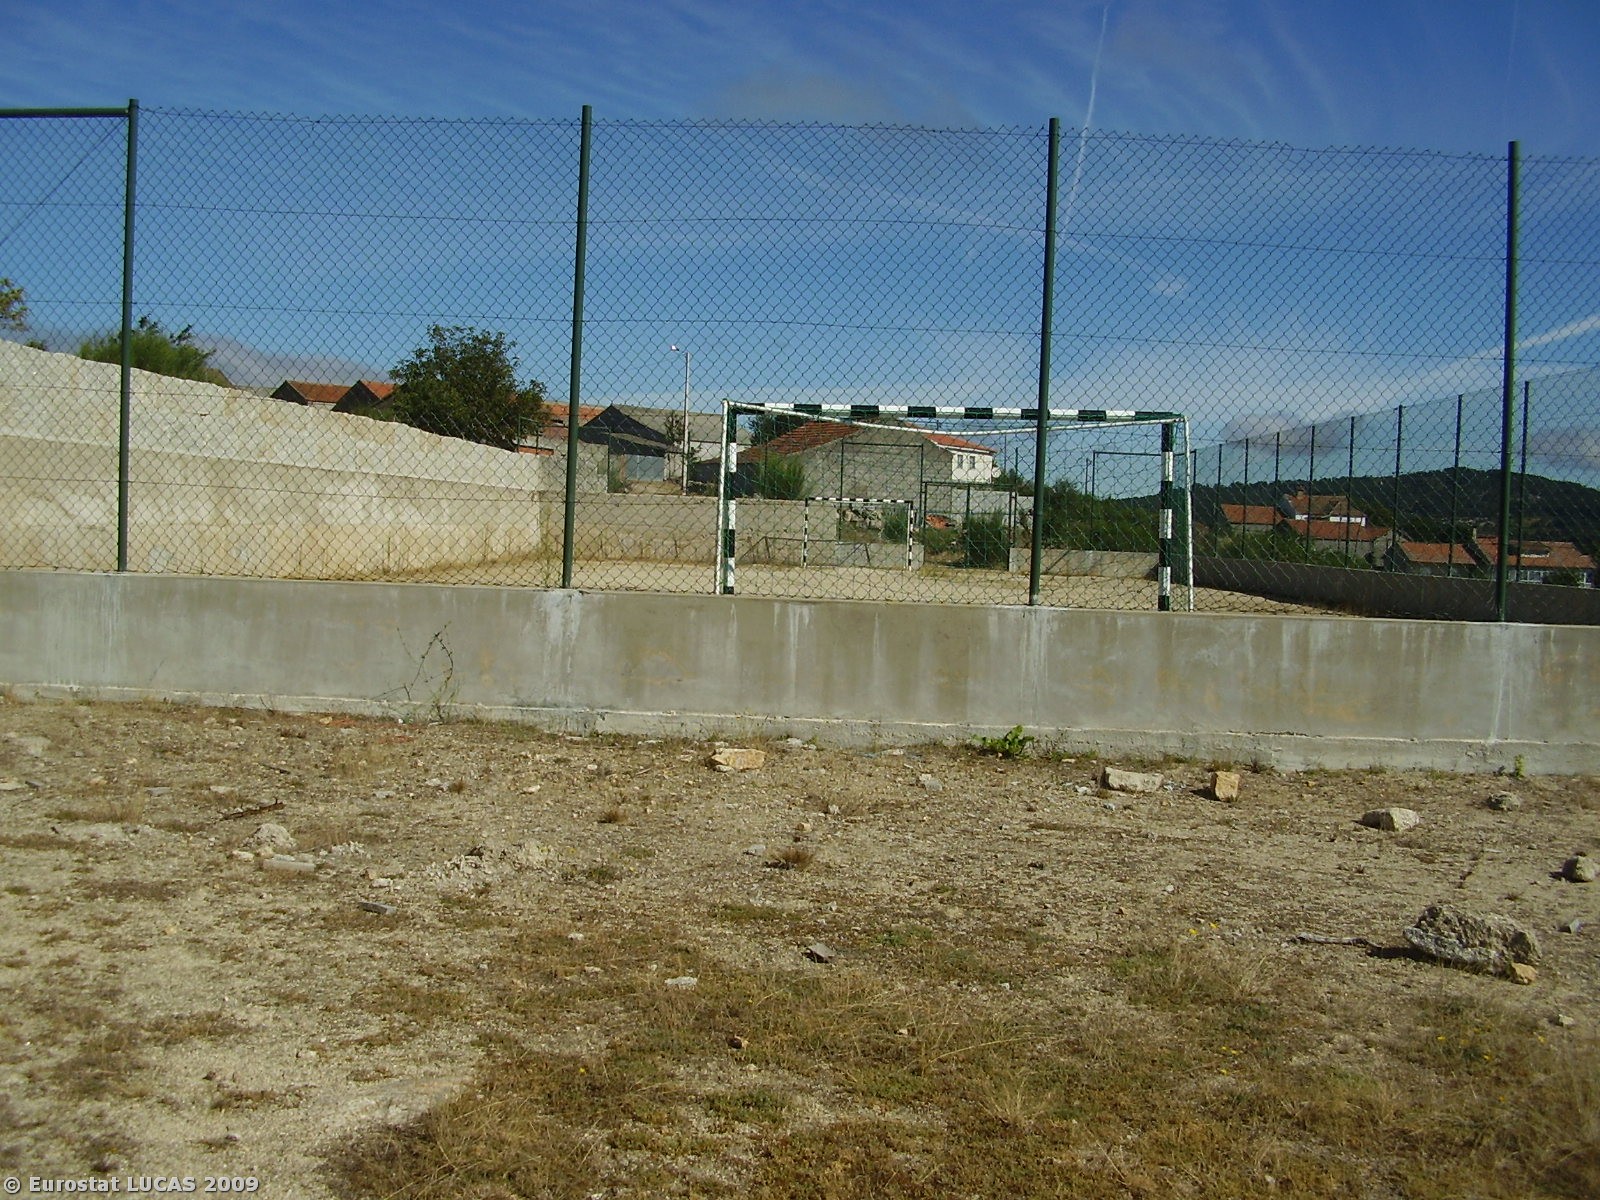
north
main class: Grassland
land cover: Spontaneously vegetated surfaces
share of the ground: 50 - 75 %
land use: Fallow land
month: September
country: PT
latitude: 41.7135
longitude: -7.7697
